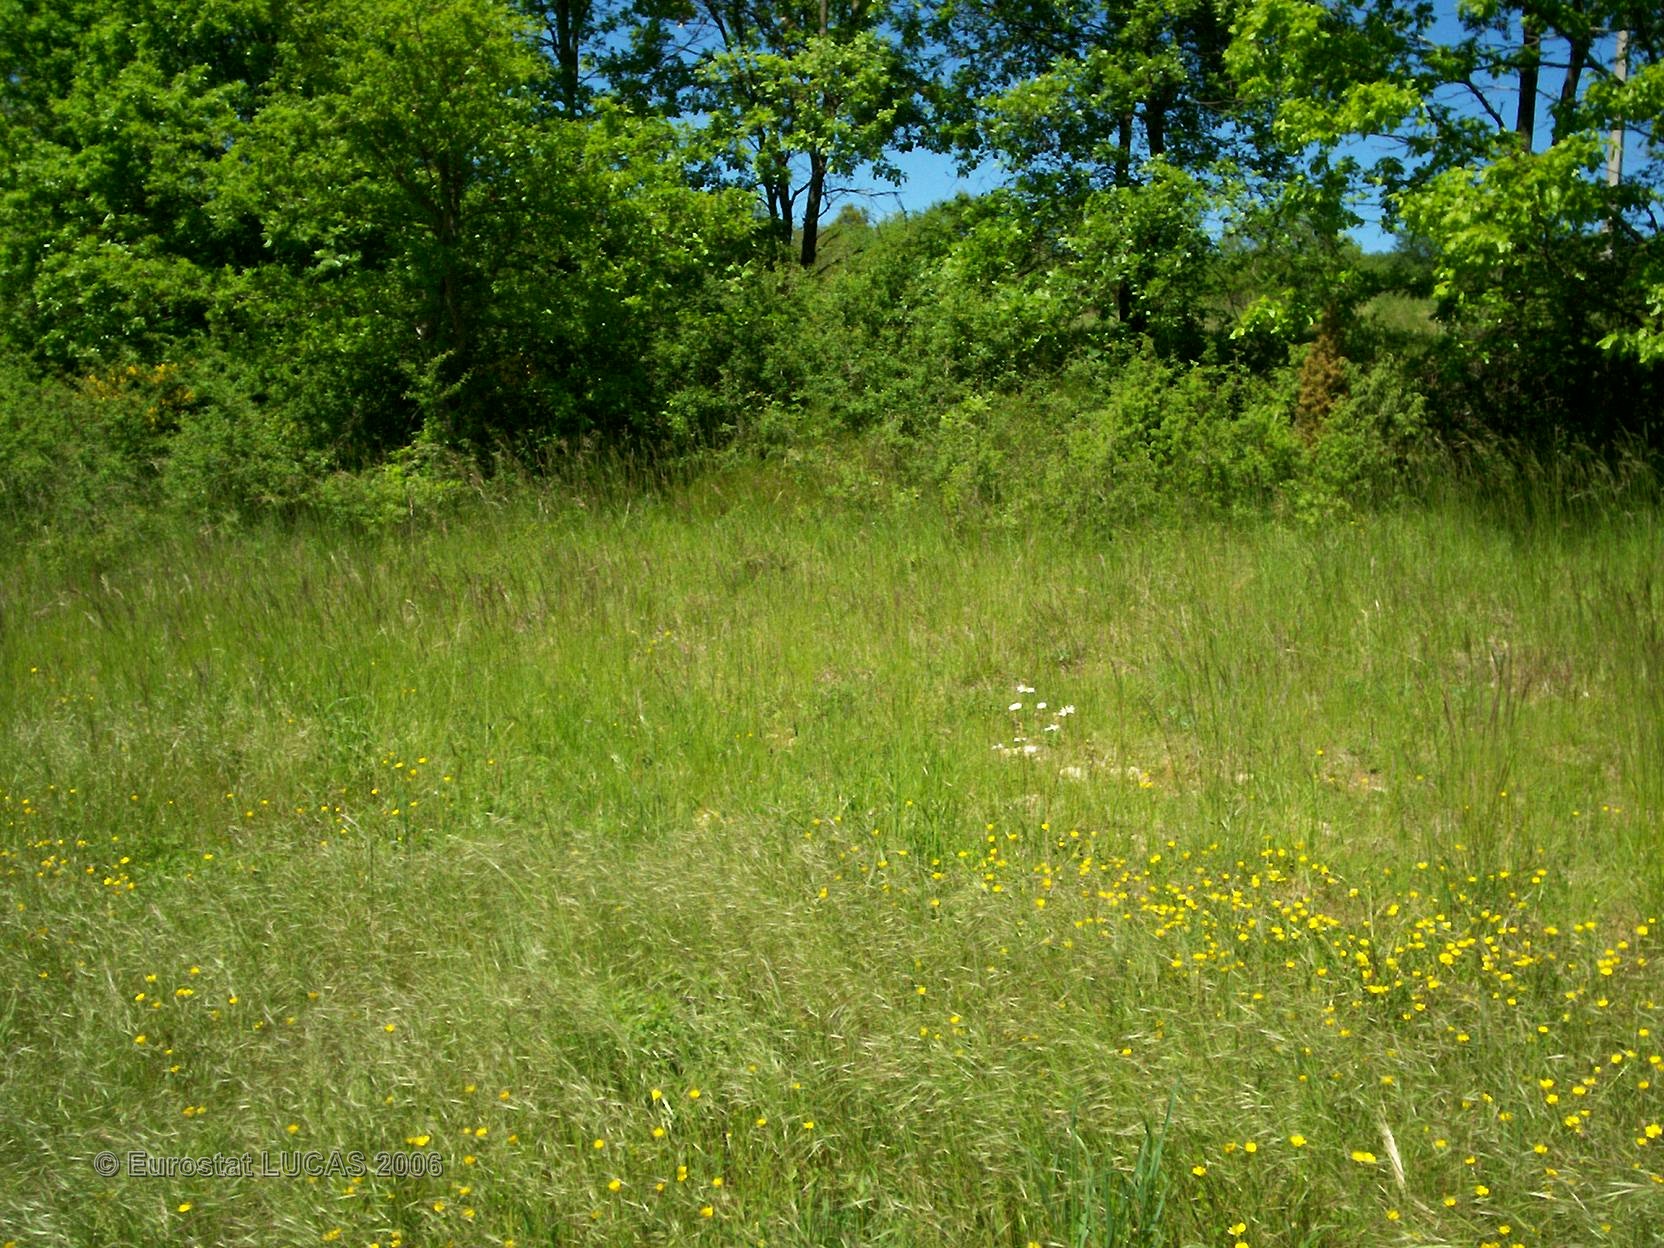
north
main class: Grassland
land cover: Grassland without tree/shrub cover
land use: Agriculture (excluding fallow land and kitchen gardens)
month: May
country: FR
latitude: 43.2066
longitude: 0.9066
